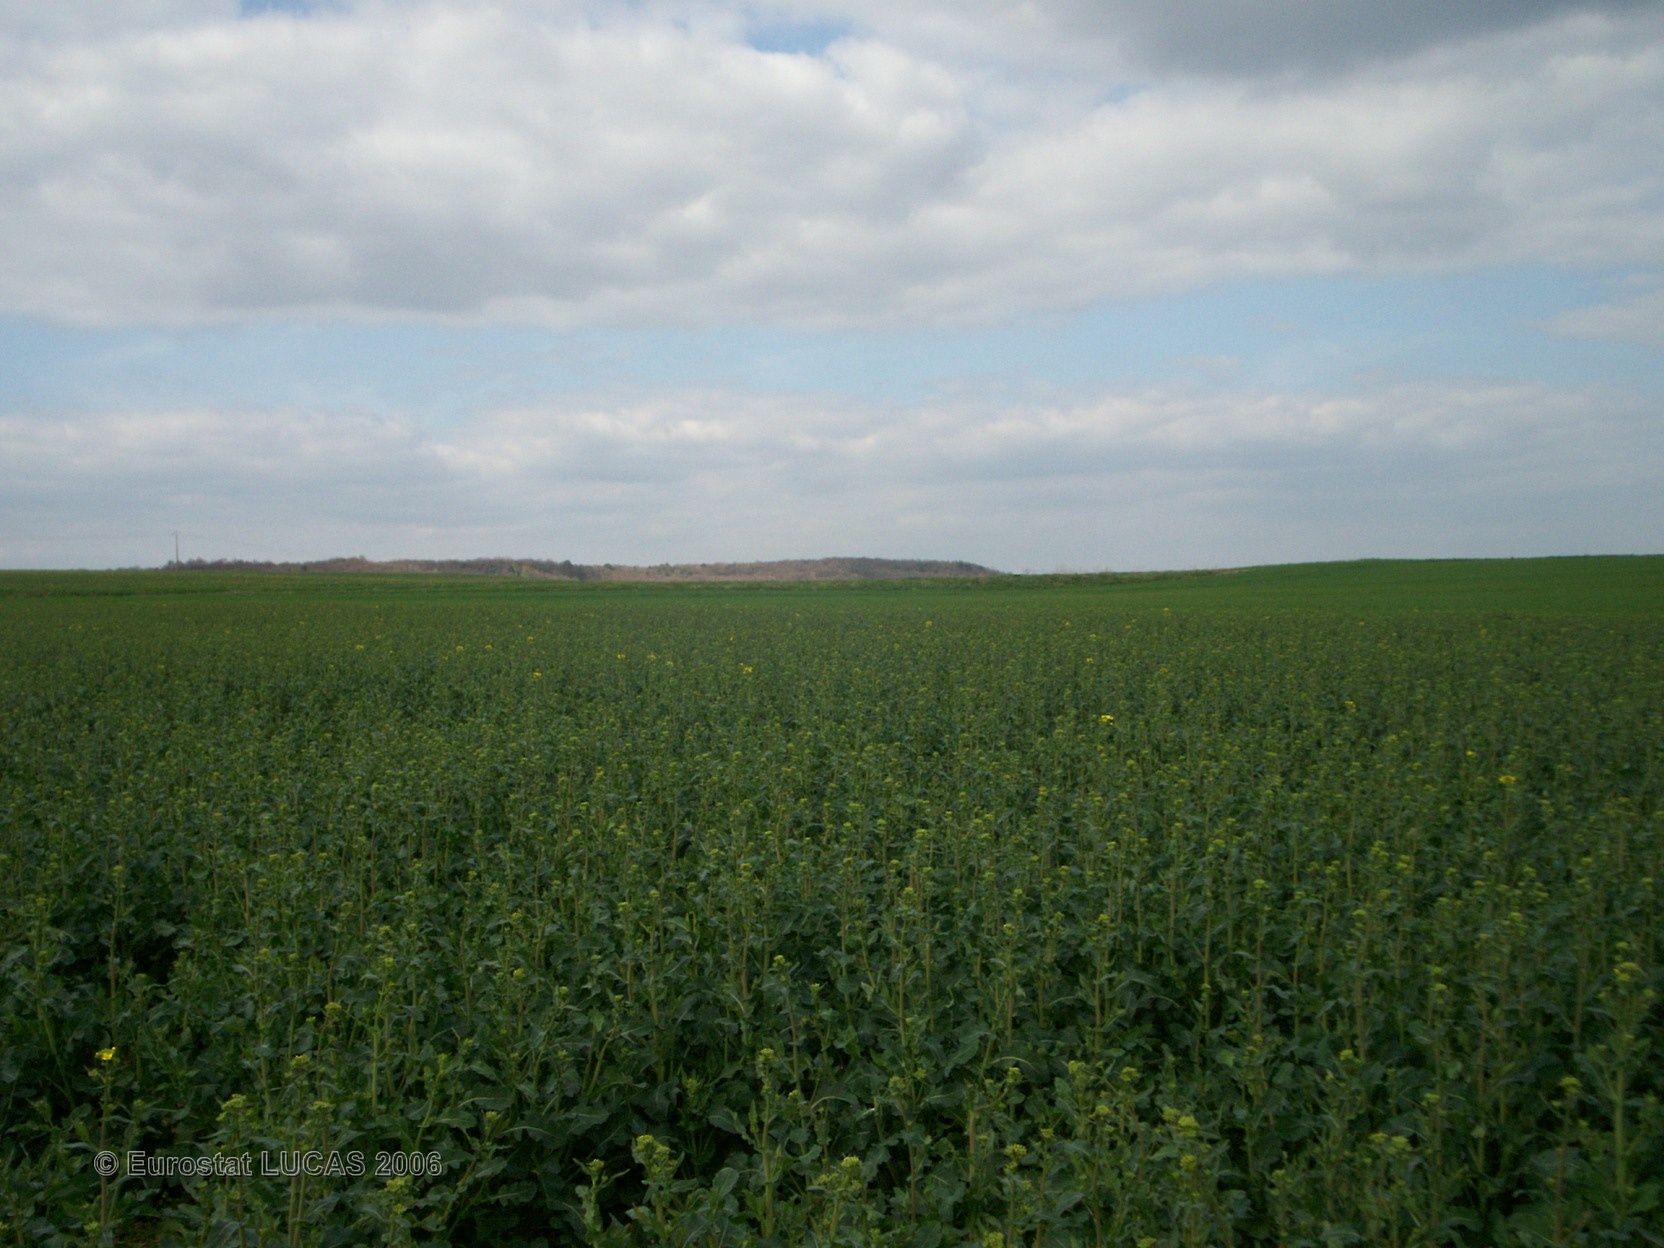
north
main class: Cropland
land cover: Rape and turnip rape
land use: Agriculture (excluding fallow land and kitchen gardens)
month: April
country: FR
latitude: 48.3152
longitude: 2.8310
